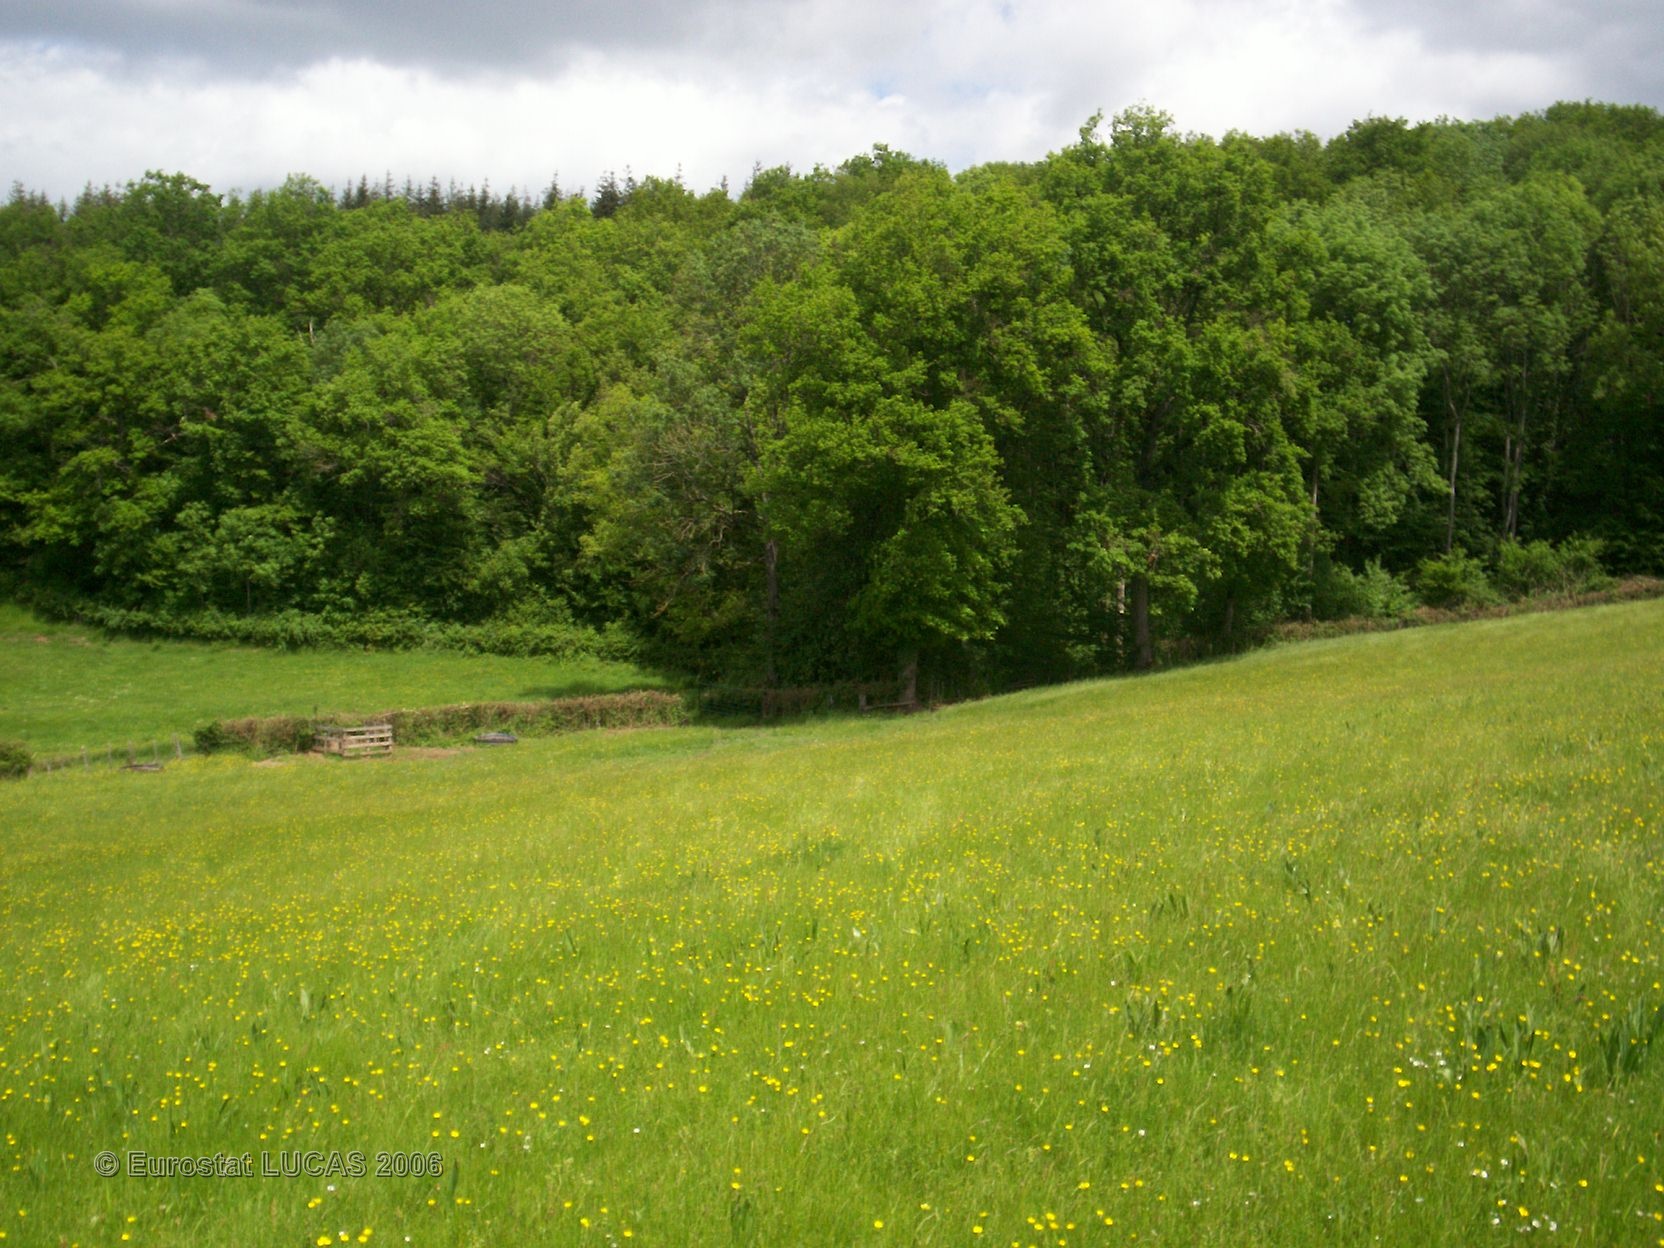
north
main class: Grassland
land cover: Grassland without tree/shrub cover
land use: Agriculture (excluding fallow land and kitchen gardens)
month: May
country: FR
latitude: 47.0445
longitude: 4.5907
